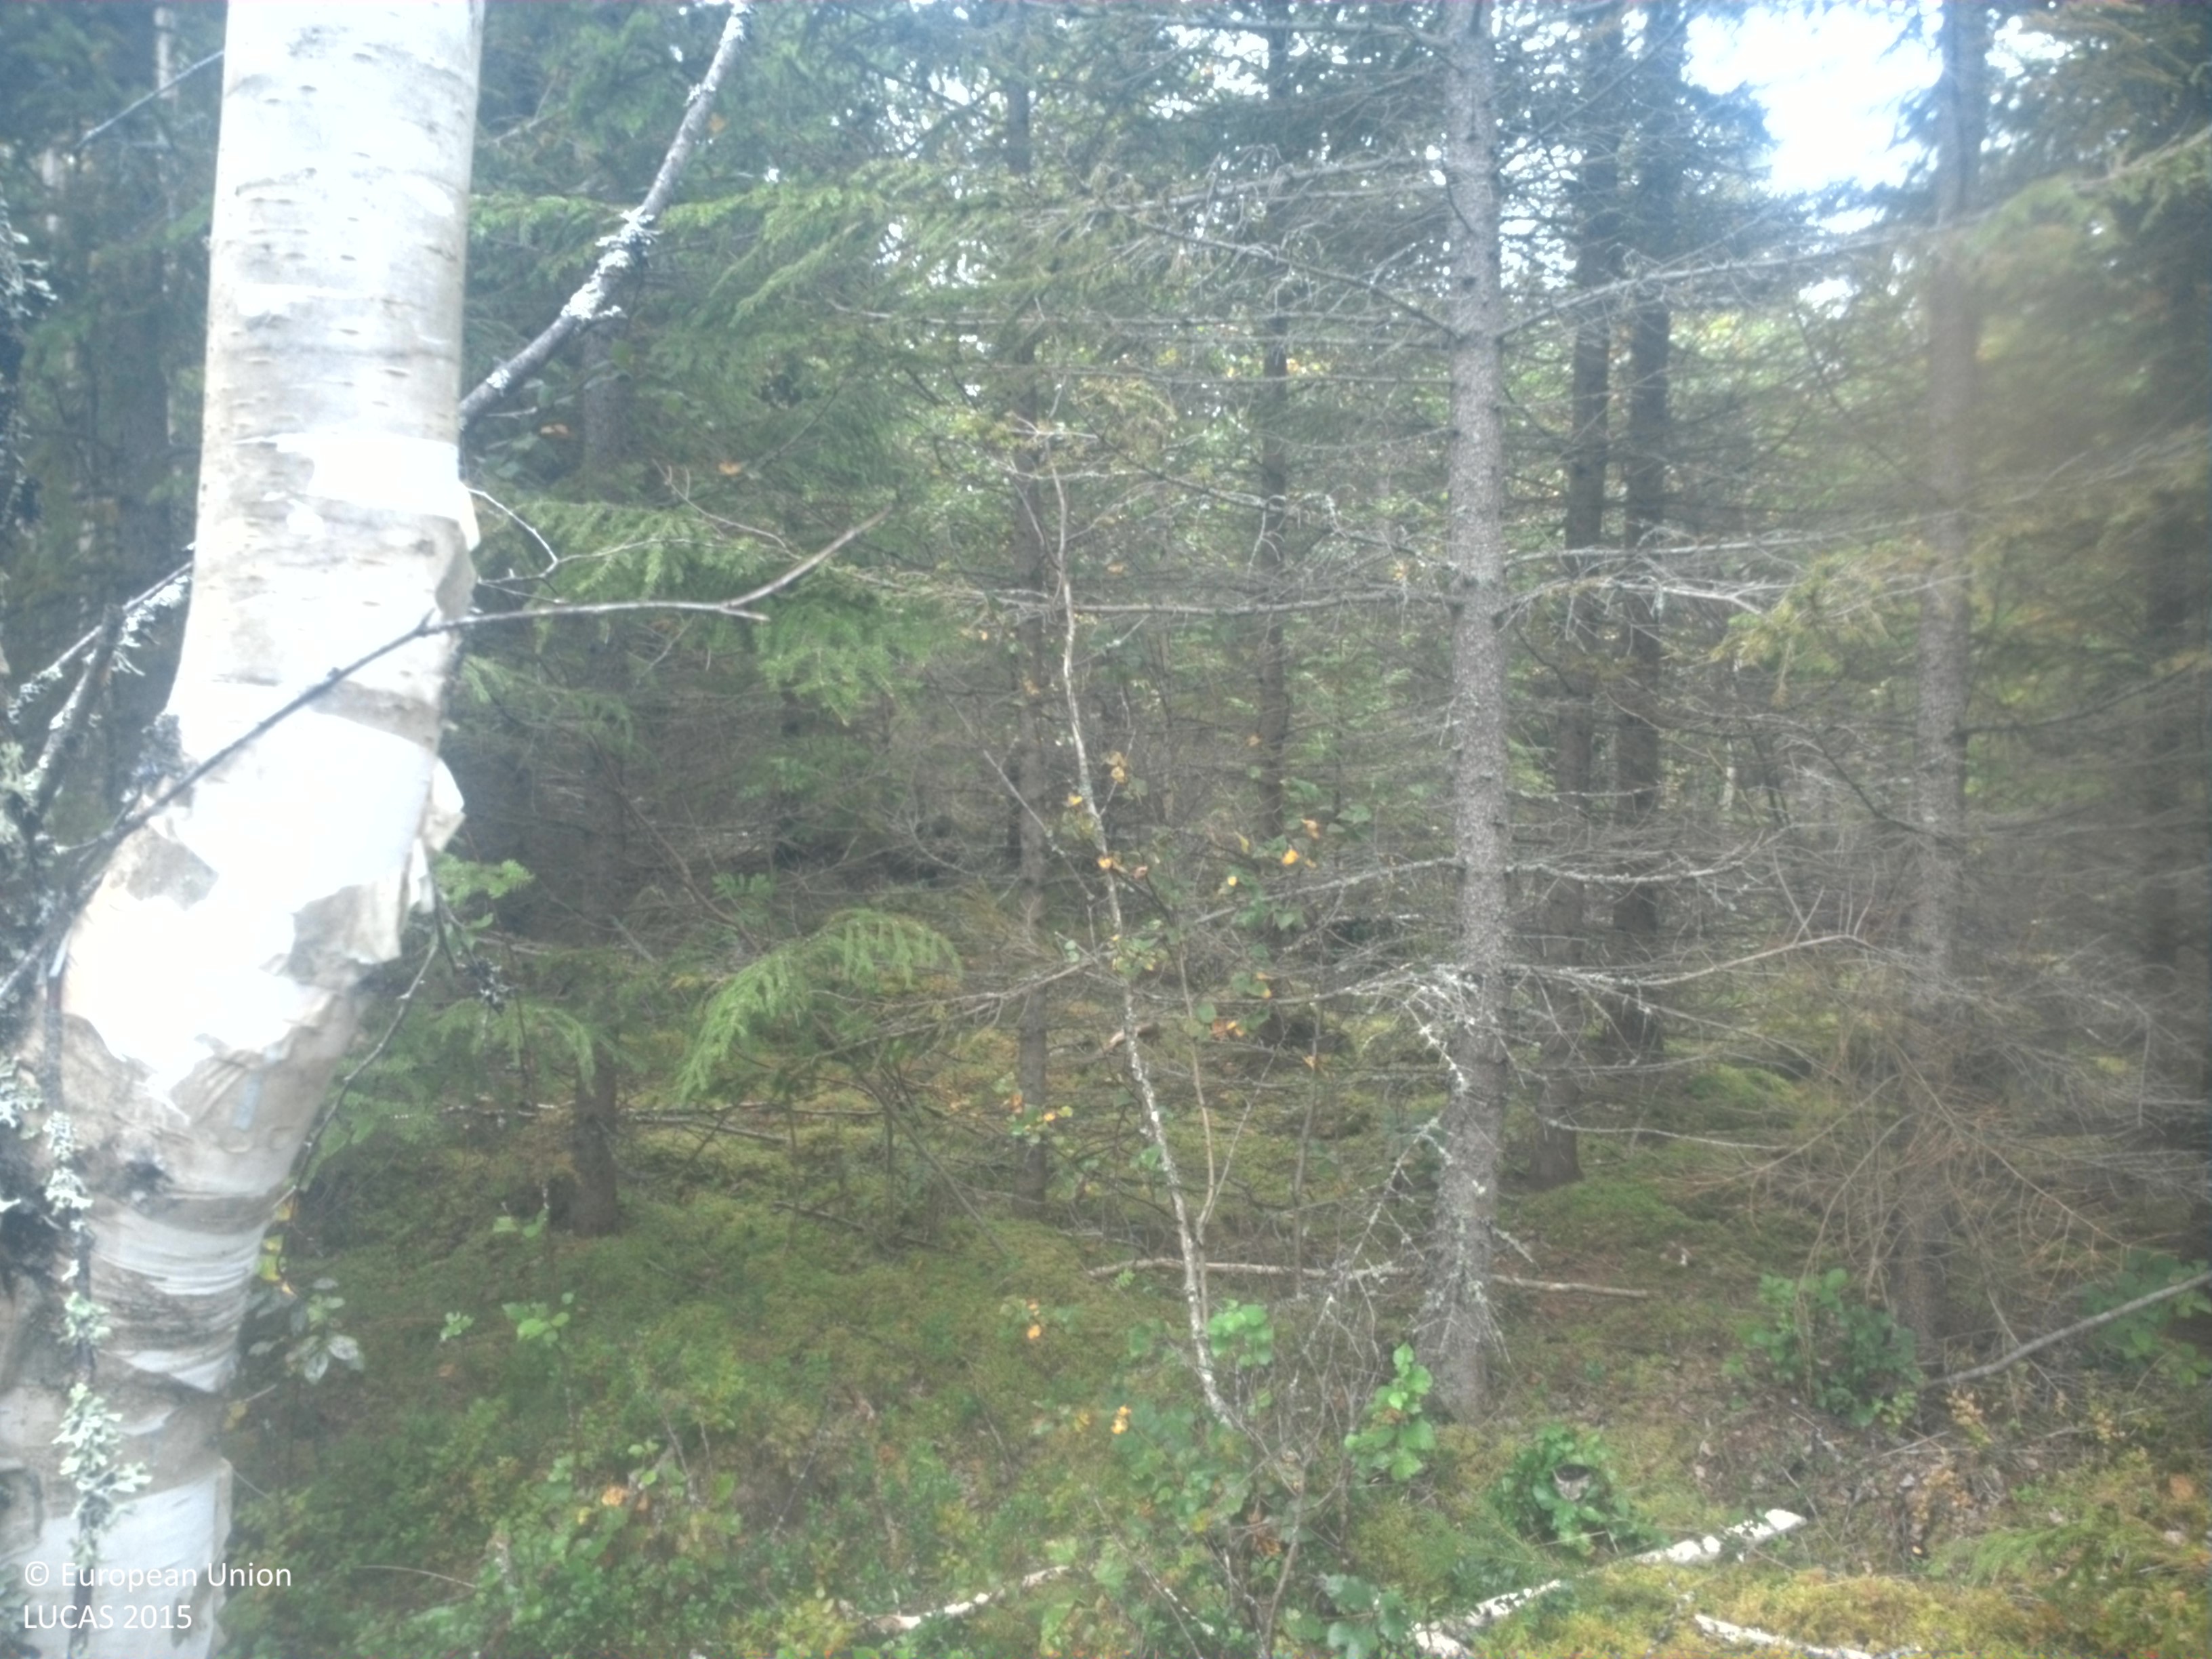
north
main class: Woodland
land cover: Spruce dominated mixed woodland
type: boreal forest
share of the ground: 50 - 75 %
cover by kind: coniferous forest trees 30 %, broadleaved forest trees 20 %, shrubs 20 %, lichens and mosses 20 %, herbaceous plants 10 %
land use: Forestry
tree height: > 5 m
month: September
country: SE
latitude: 58.8795
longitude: 14.0345
